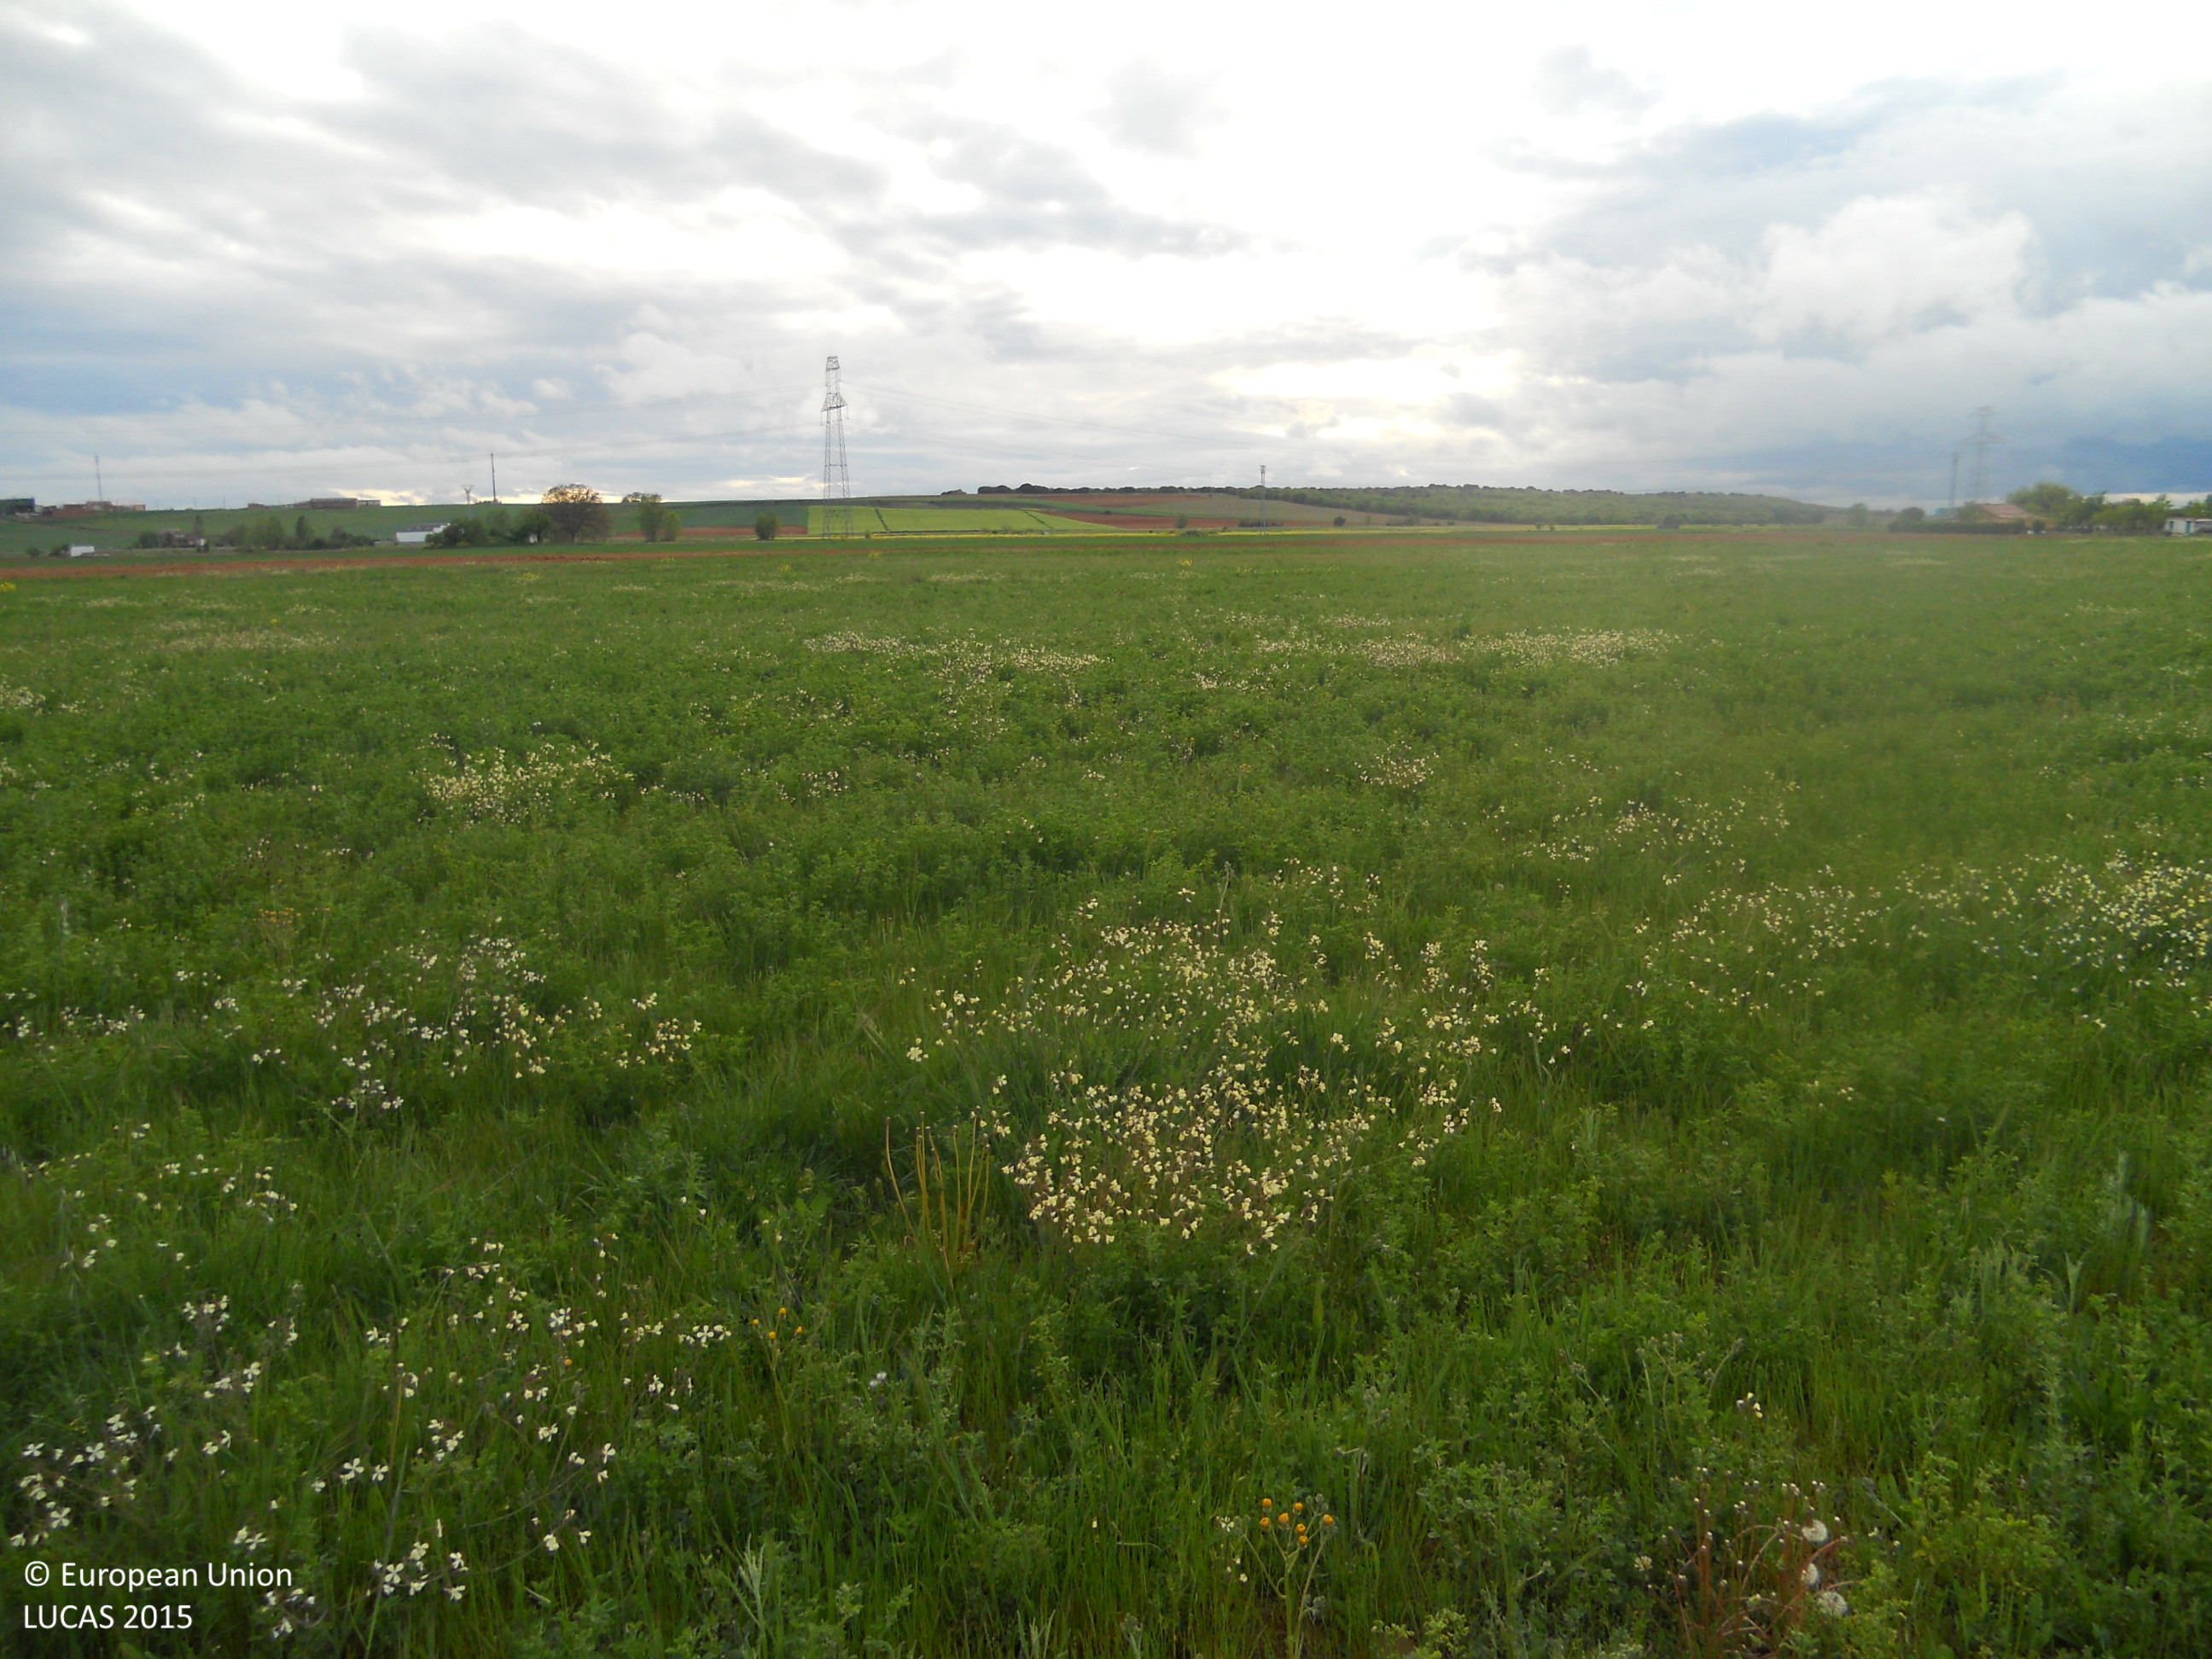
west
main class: Cropland
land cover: Lucerne
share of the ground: > 75 %
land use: Agriculture (excluding fallow land and kitchen gardens)
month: May
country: ES
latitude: 42.3109
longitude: -5.2893
